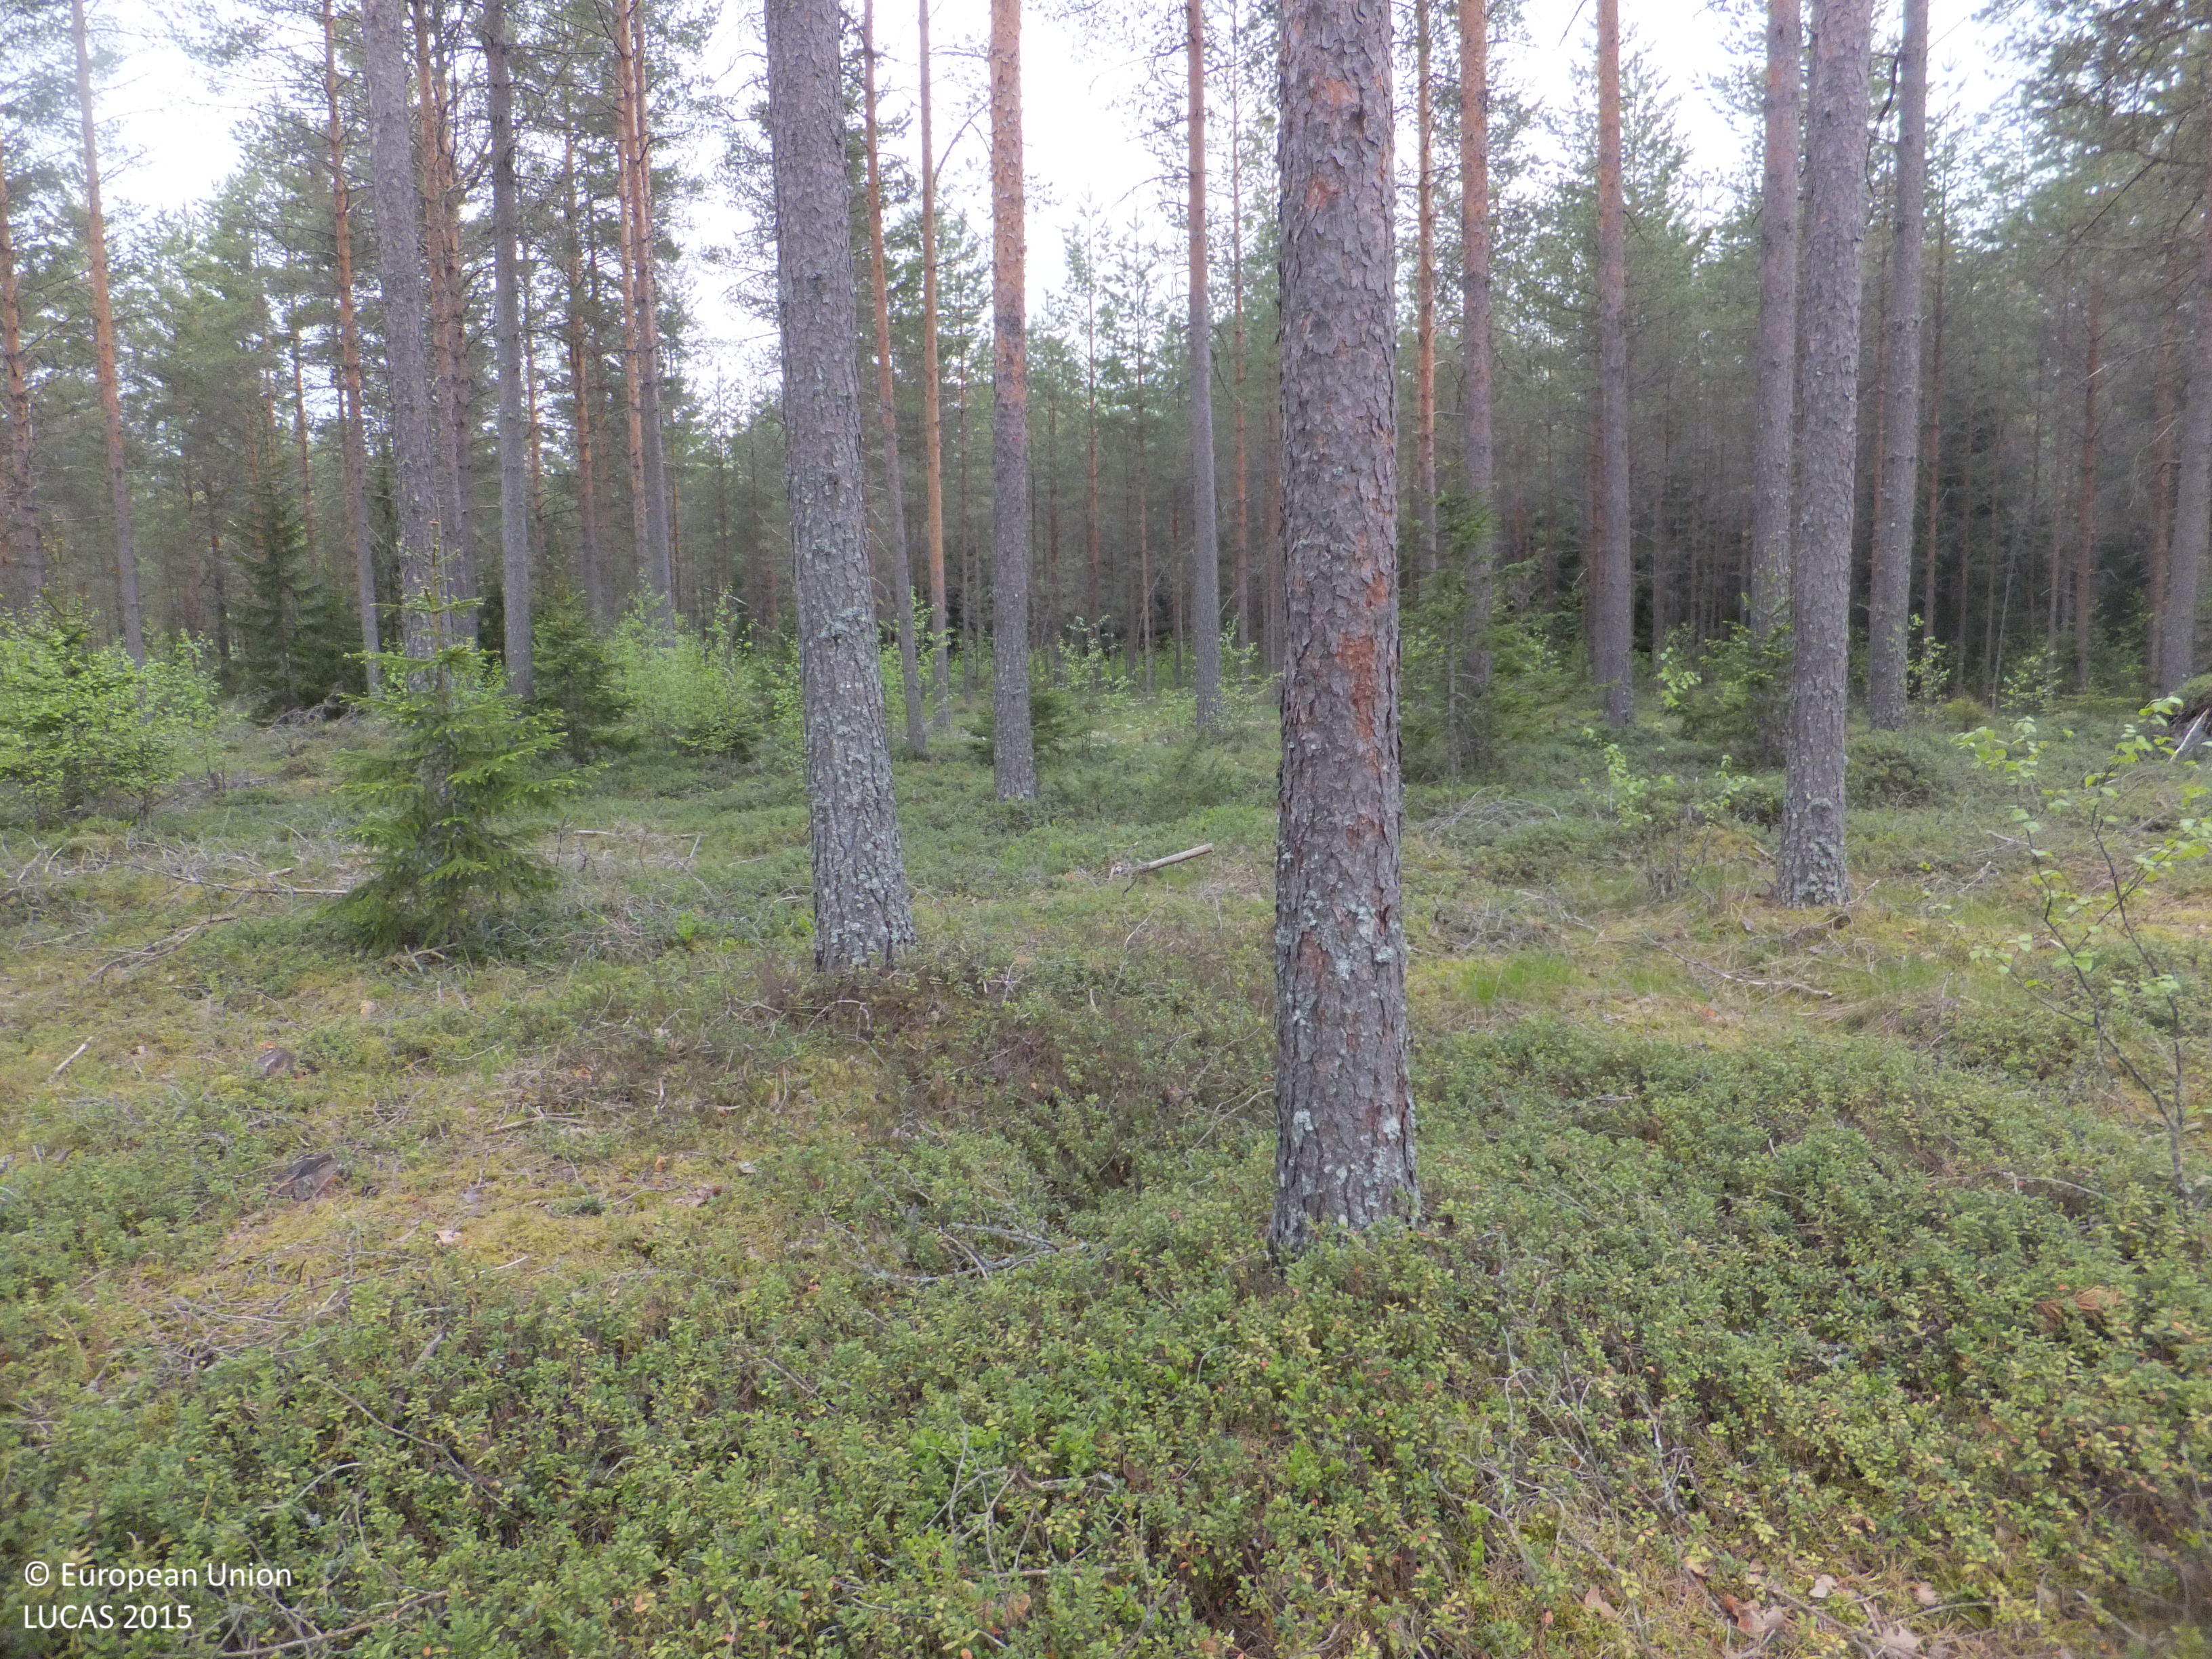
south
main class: Woodland
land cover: Pine dominated coniferous woodland
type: boreal forest
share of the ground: > 75 %
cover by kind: coniferous forest trees 90 %, shrubs 5 %, lichens and mosses 5 %
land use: Forestry
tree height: > 5 m
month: June
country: FI
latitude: 63.5130
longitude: 22.7722
